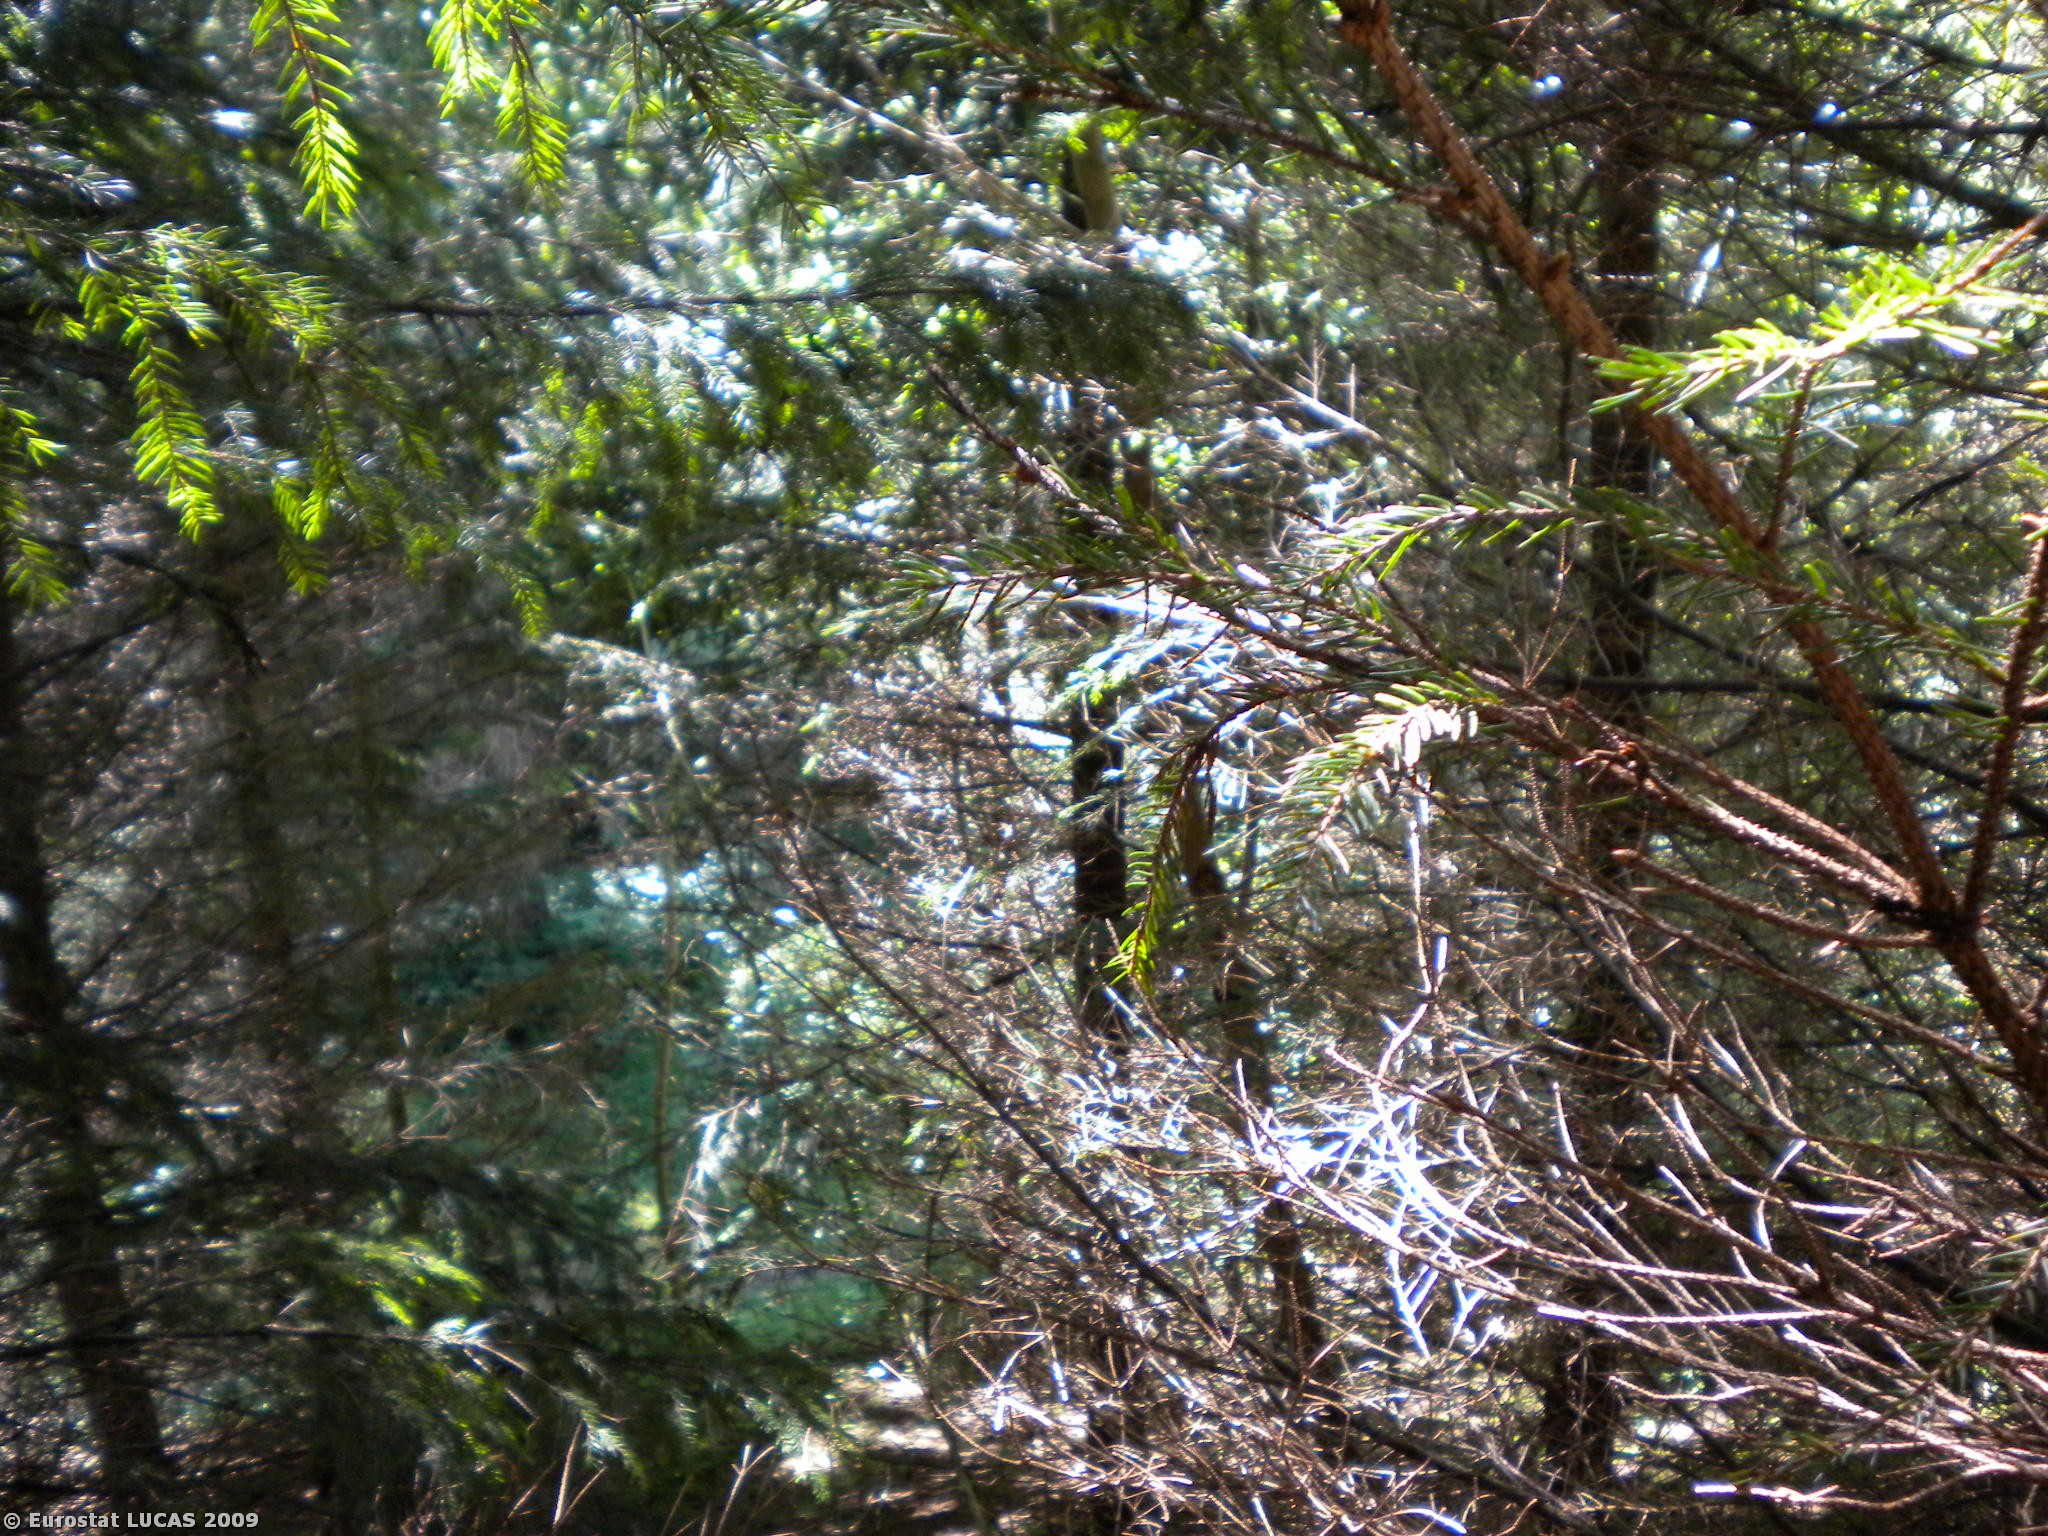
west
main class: Woodland
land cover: Coniferous woodland
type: alpine coniferous forest
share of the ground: > 75 %
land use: Forestry
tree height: > 5 m
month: July
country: AT
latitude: 46.6879
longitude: 12.9916
